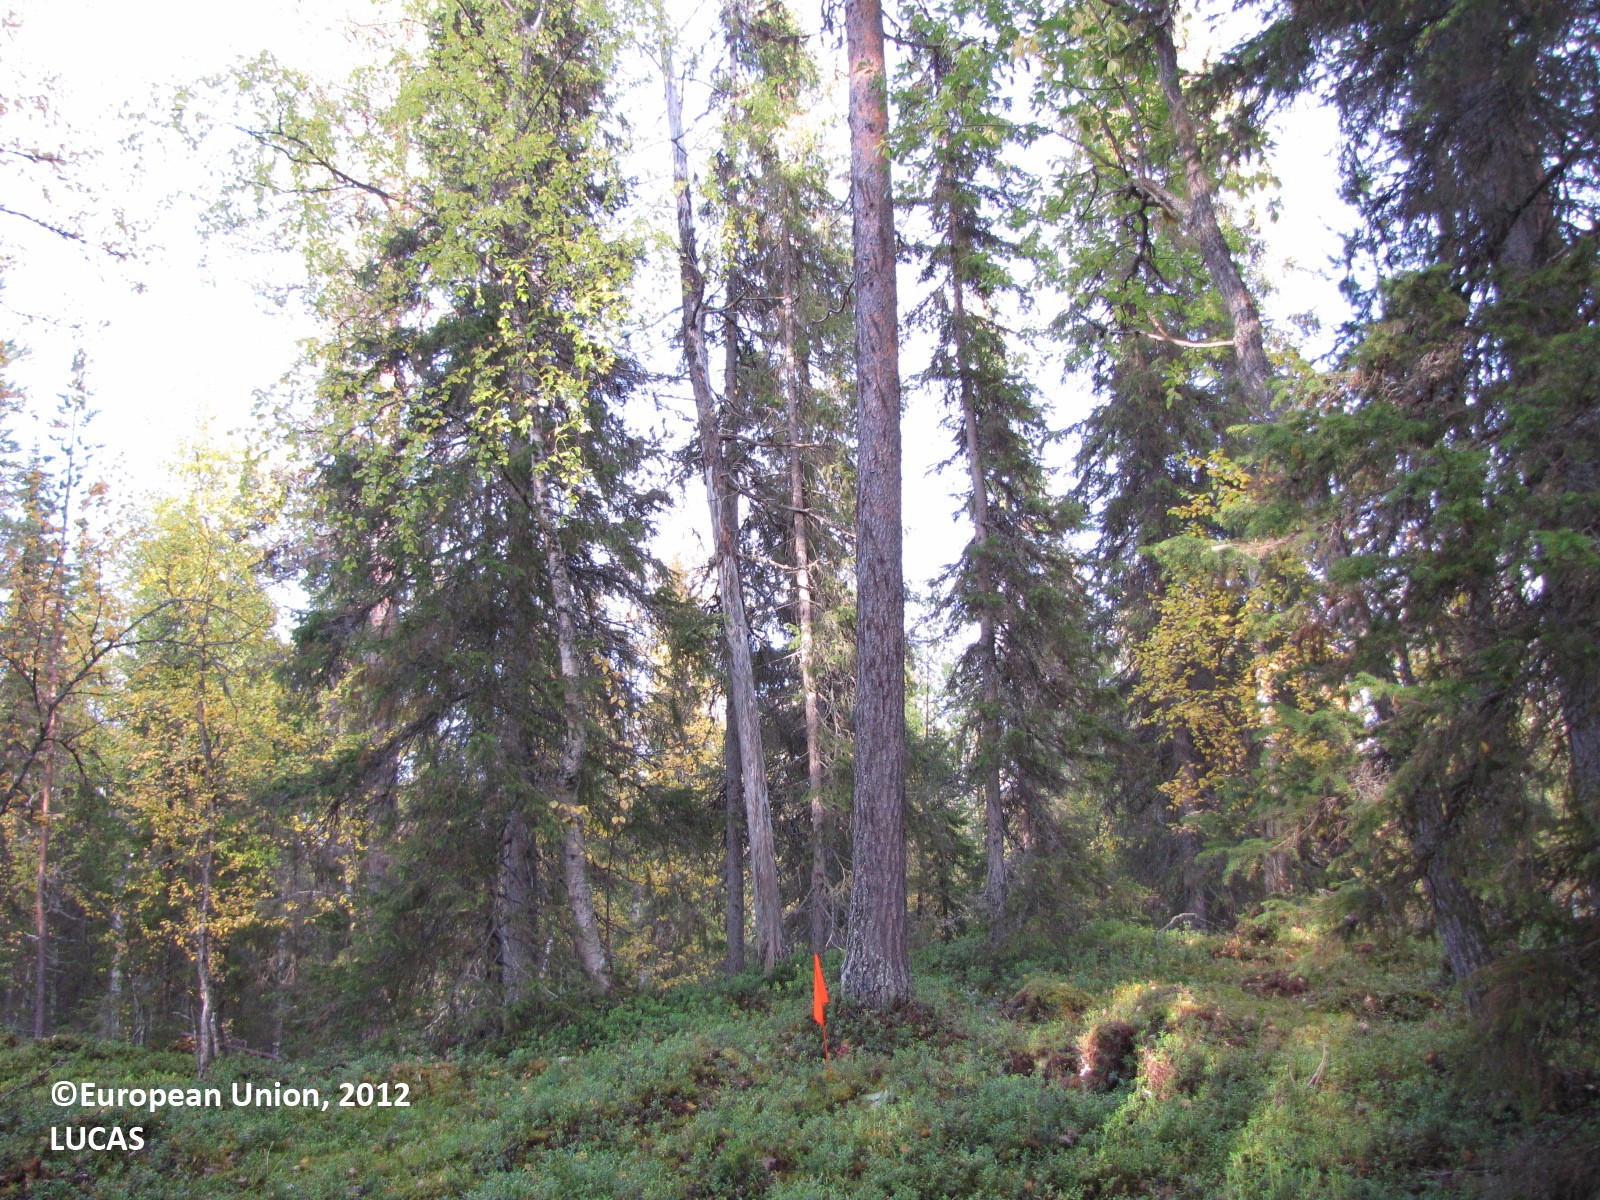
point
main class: Woodland
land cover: Other mixed woodland
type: boreal forest
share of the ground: 25 - 50 %
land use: Forestry
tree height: > 5 m
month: September
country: FI
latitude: 67.3314
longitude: 25.3243
